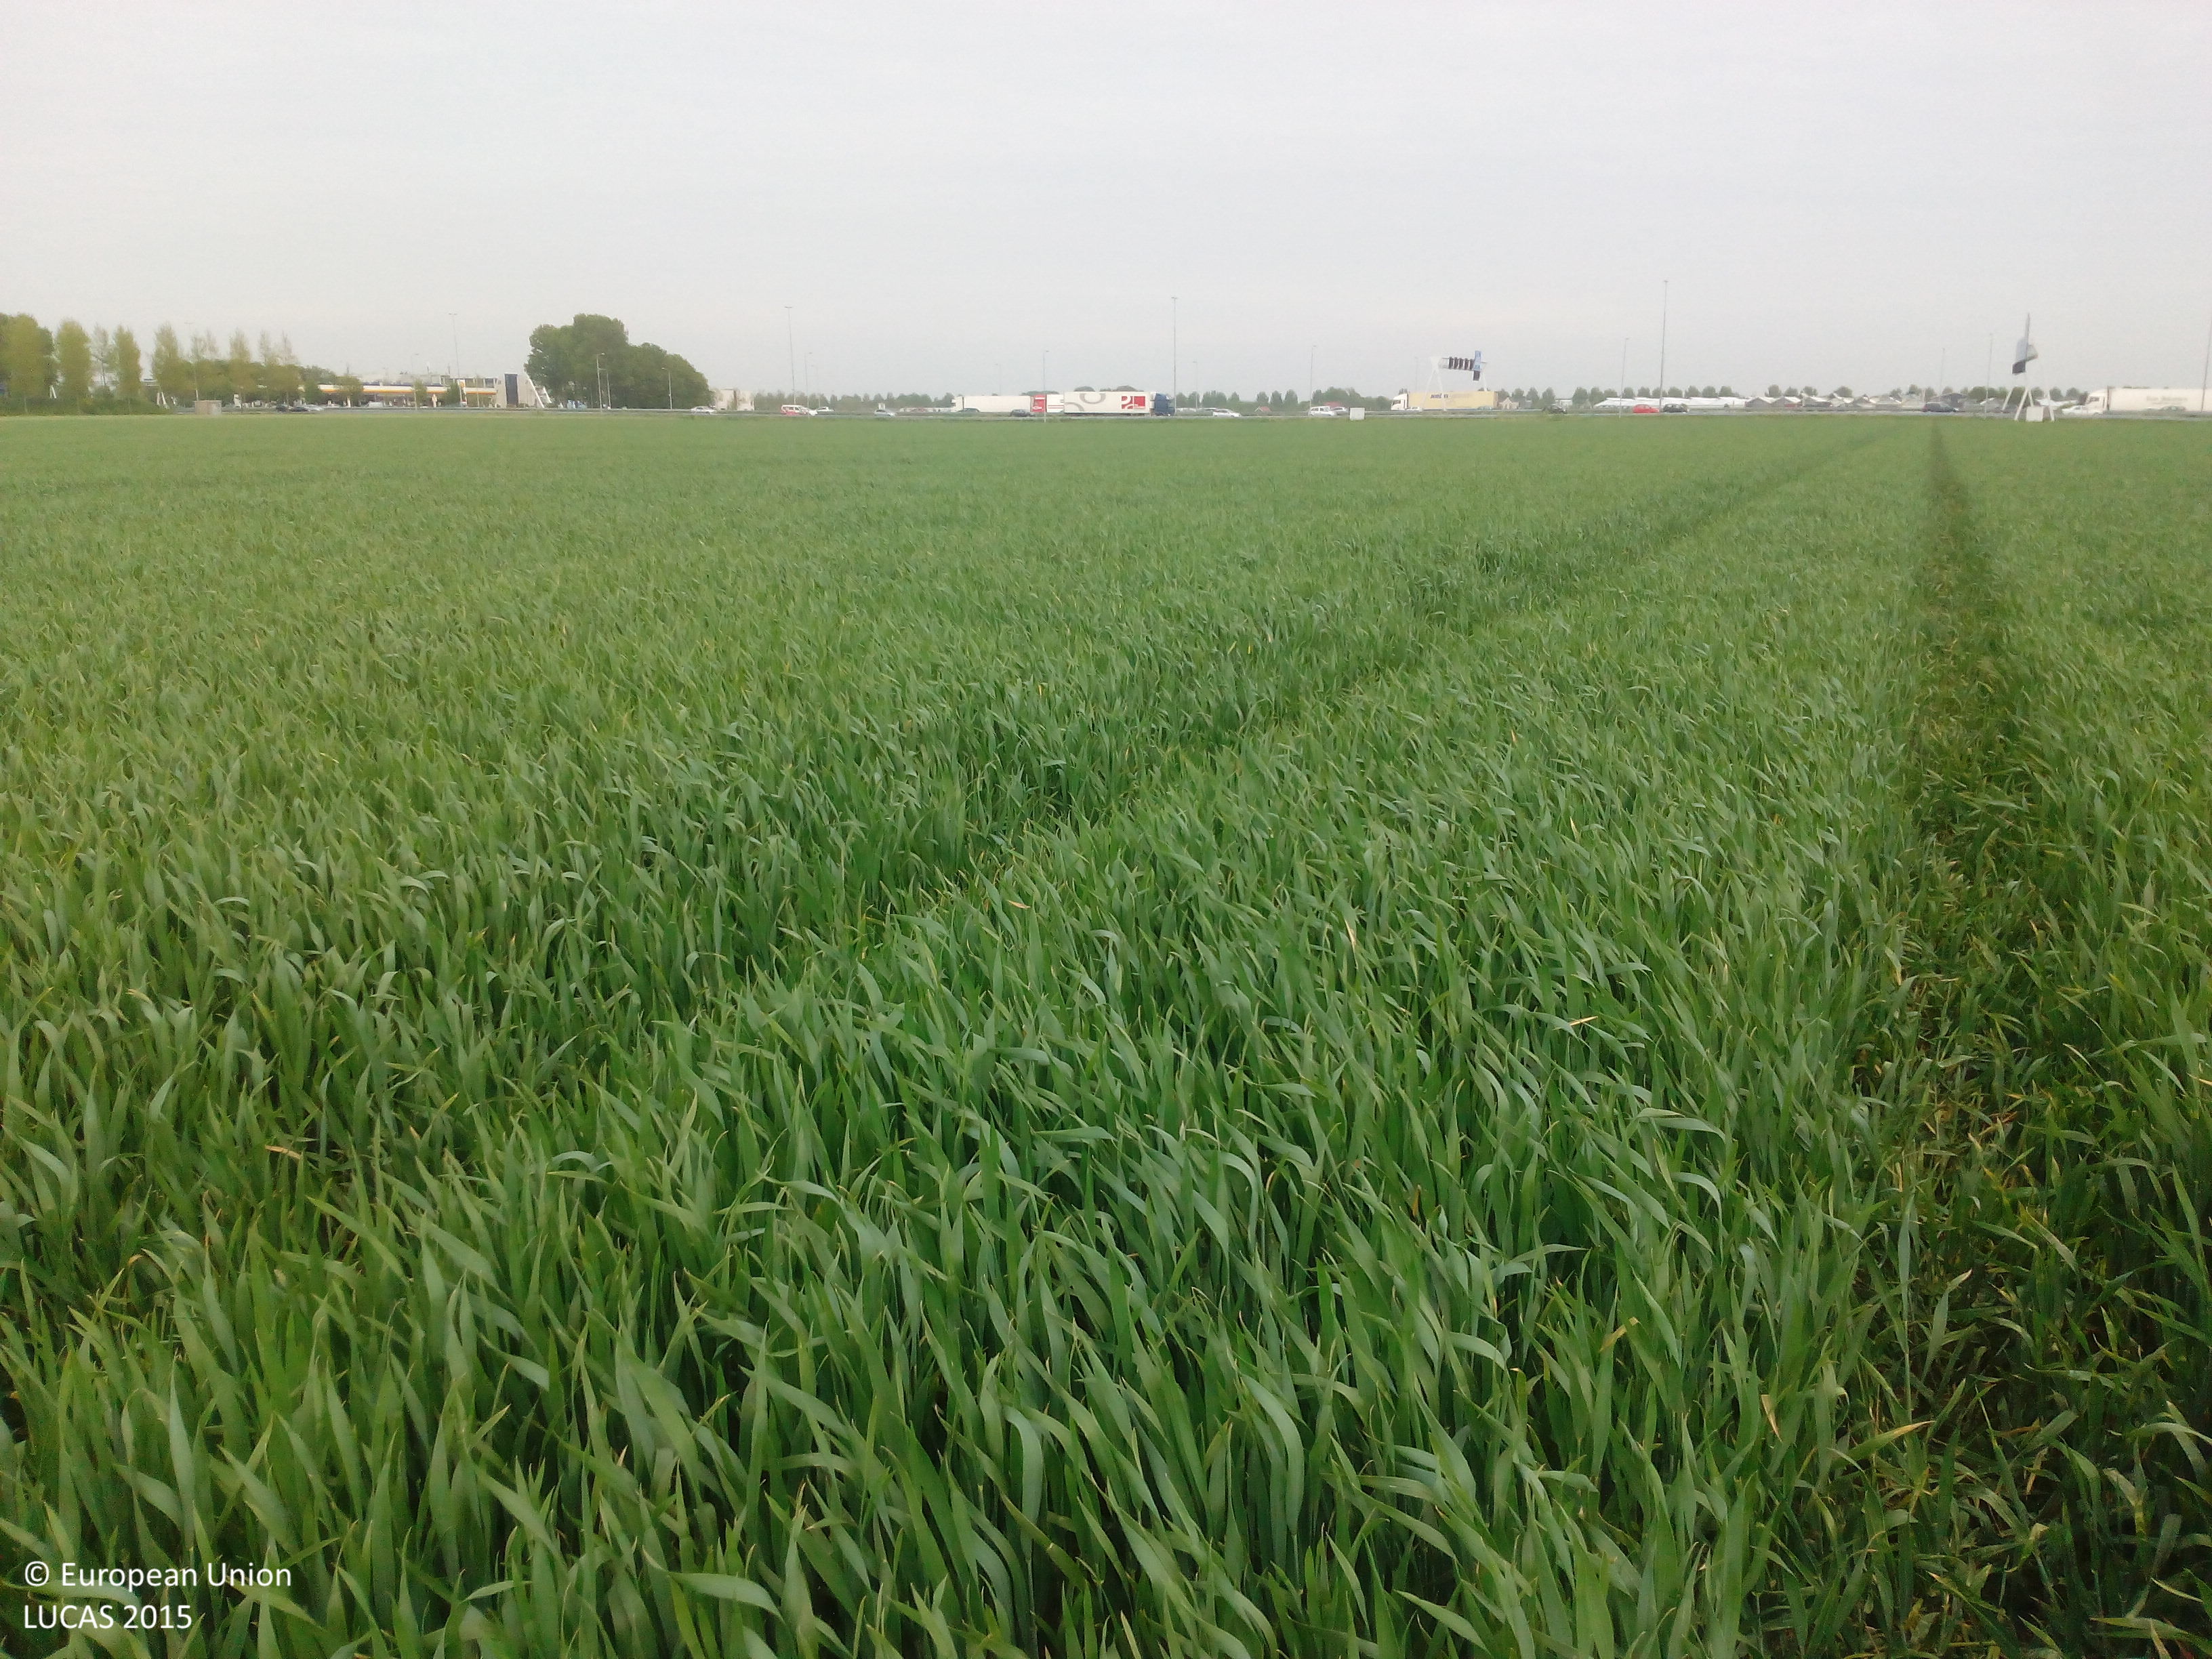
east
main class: Cropland
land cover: Common wheat
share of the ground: > 75 %
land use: Agriculture (excluding fallow land and kitchen gardens)
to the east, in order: Common wheat; Ditches and canals
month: May
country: NL
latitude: 52.2582
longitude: 4.6784
